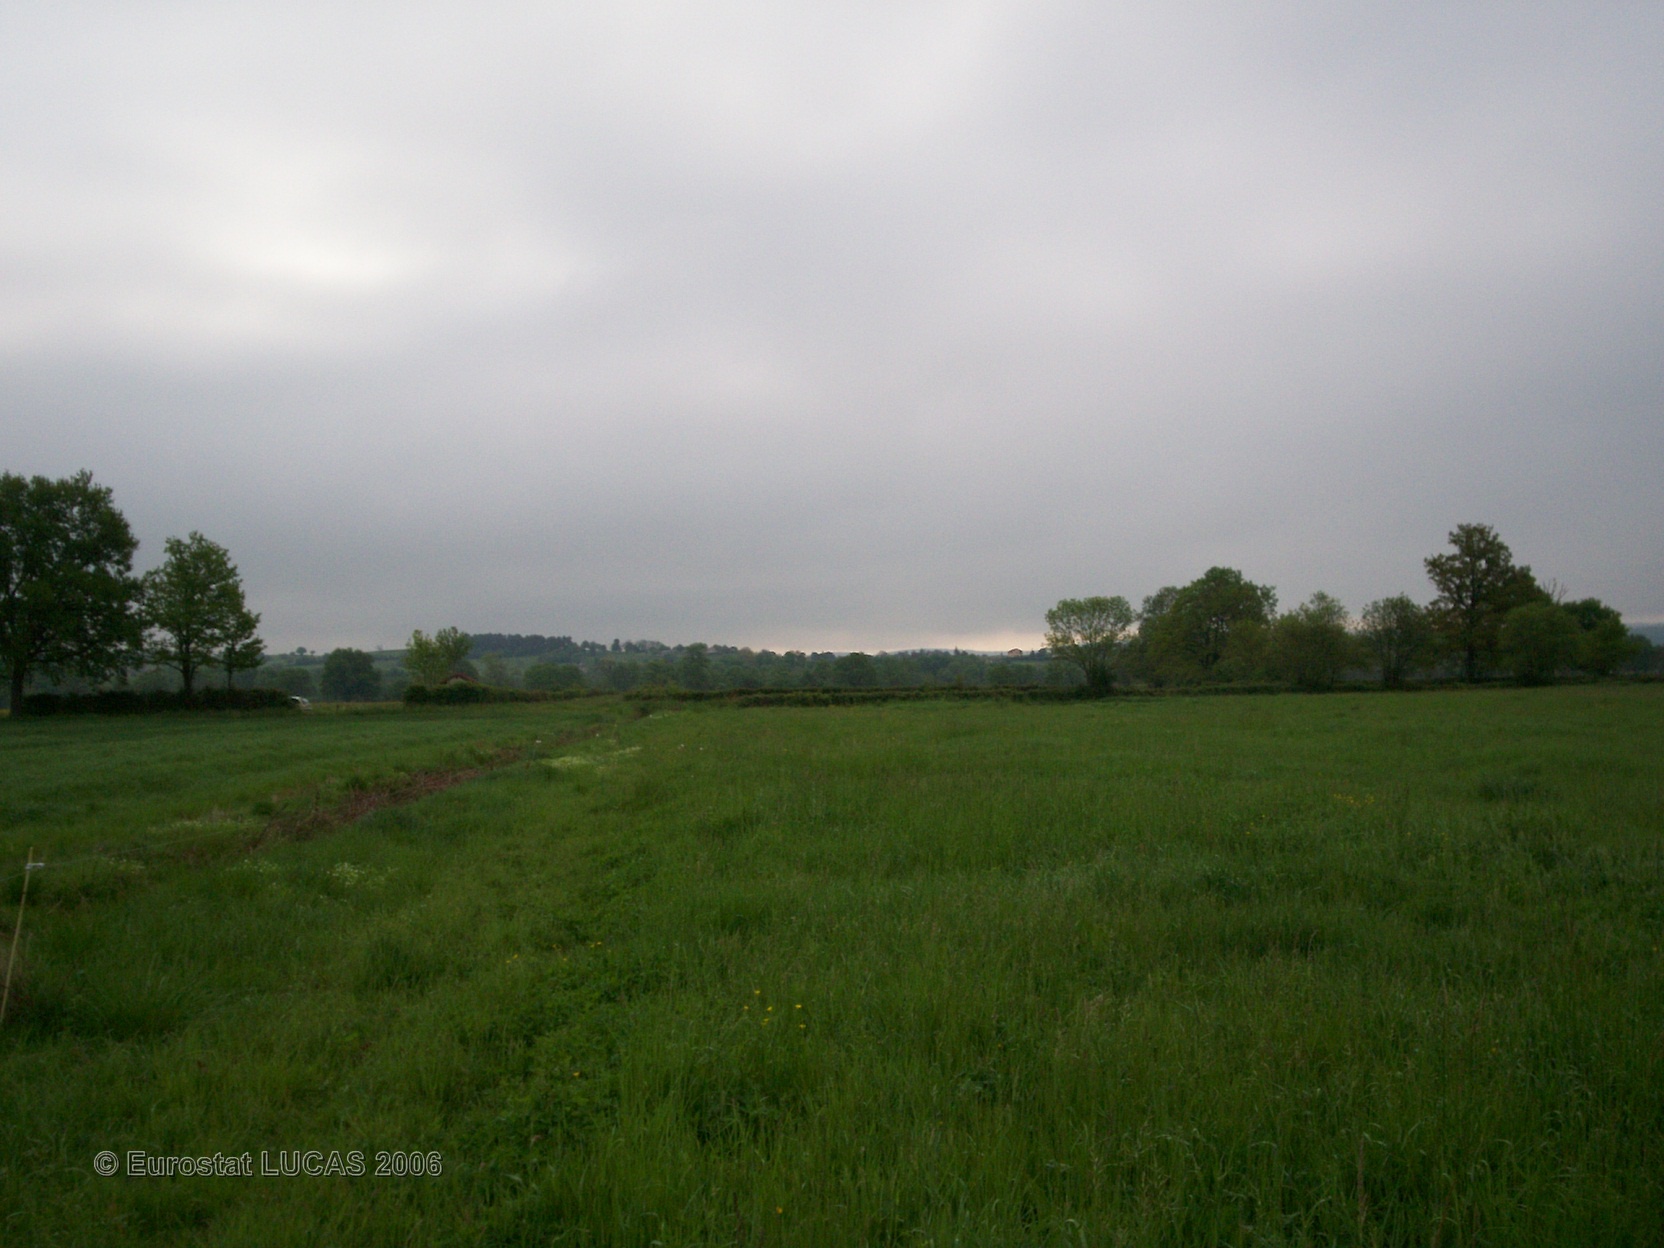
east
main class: Grassland
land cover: Grassland without tree/shrub cover
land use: Agriculture (excluding fallow land and kitchen gardens)
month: May
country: FR
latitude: 46.5431
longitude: 4.6679
